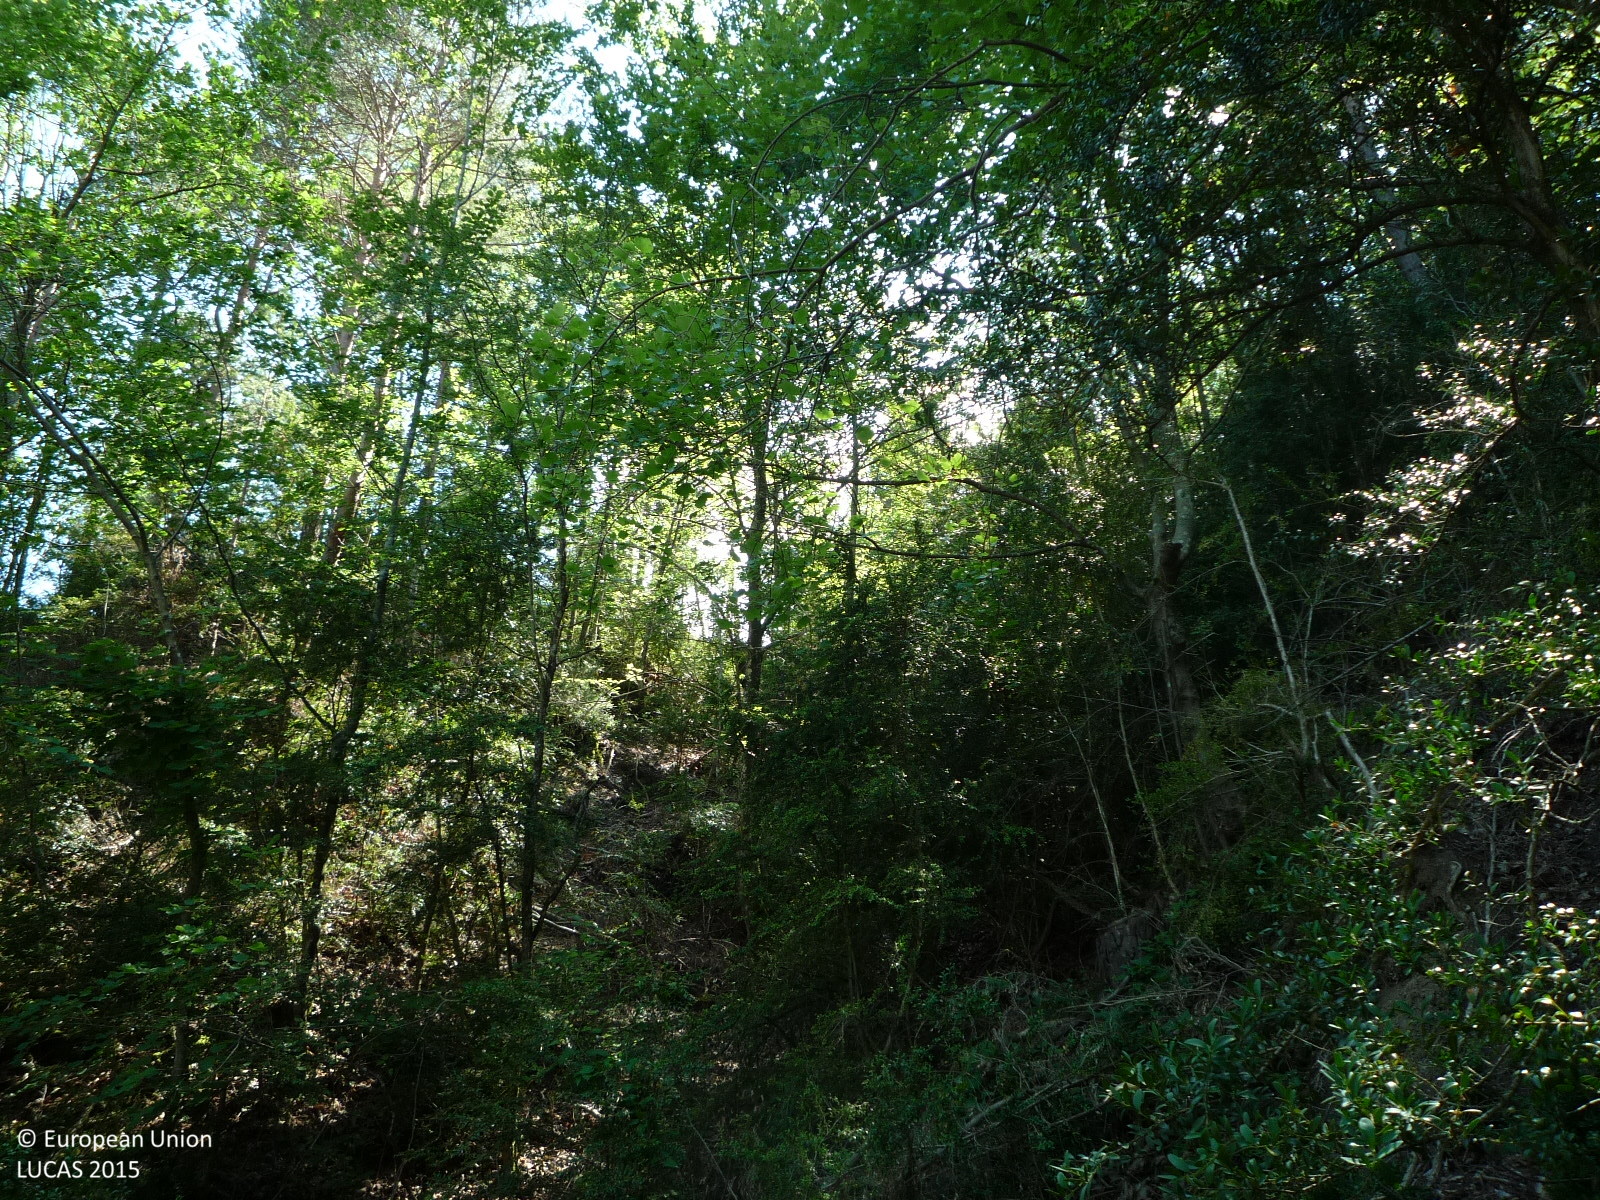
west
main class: Woodland
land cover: Pine dominated mixed woodland
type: coniferous forest of the mediterranean region
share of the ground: > 75 %
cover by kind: coniferous forest trees 55 %, broadleaved forest trees 45 %
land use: Forestry
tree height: > 5 m
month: June
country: ES
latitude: 42.1549
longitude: 1.9892
